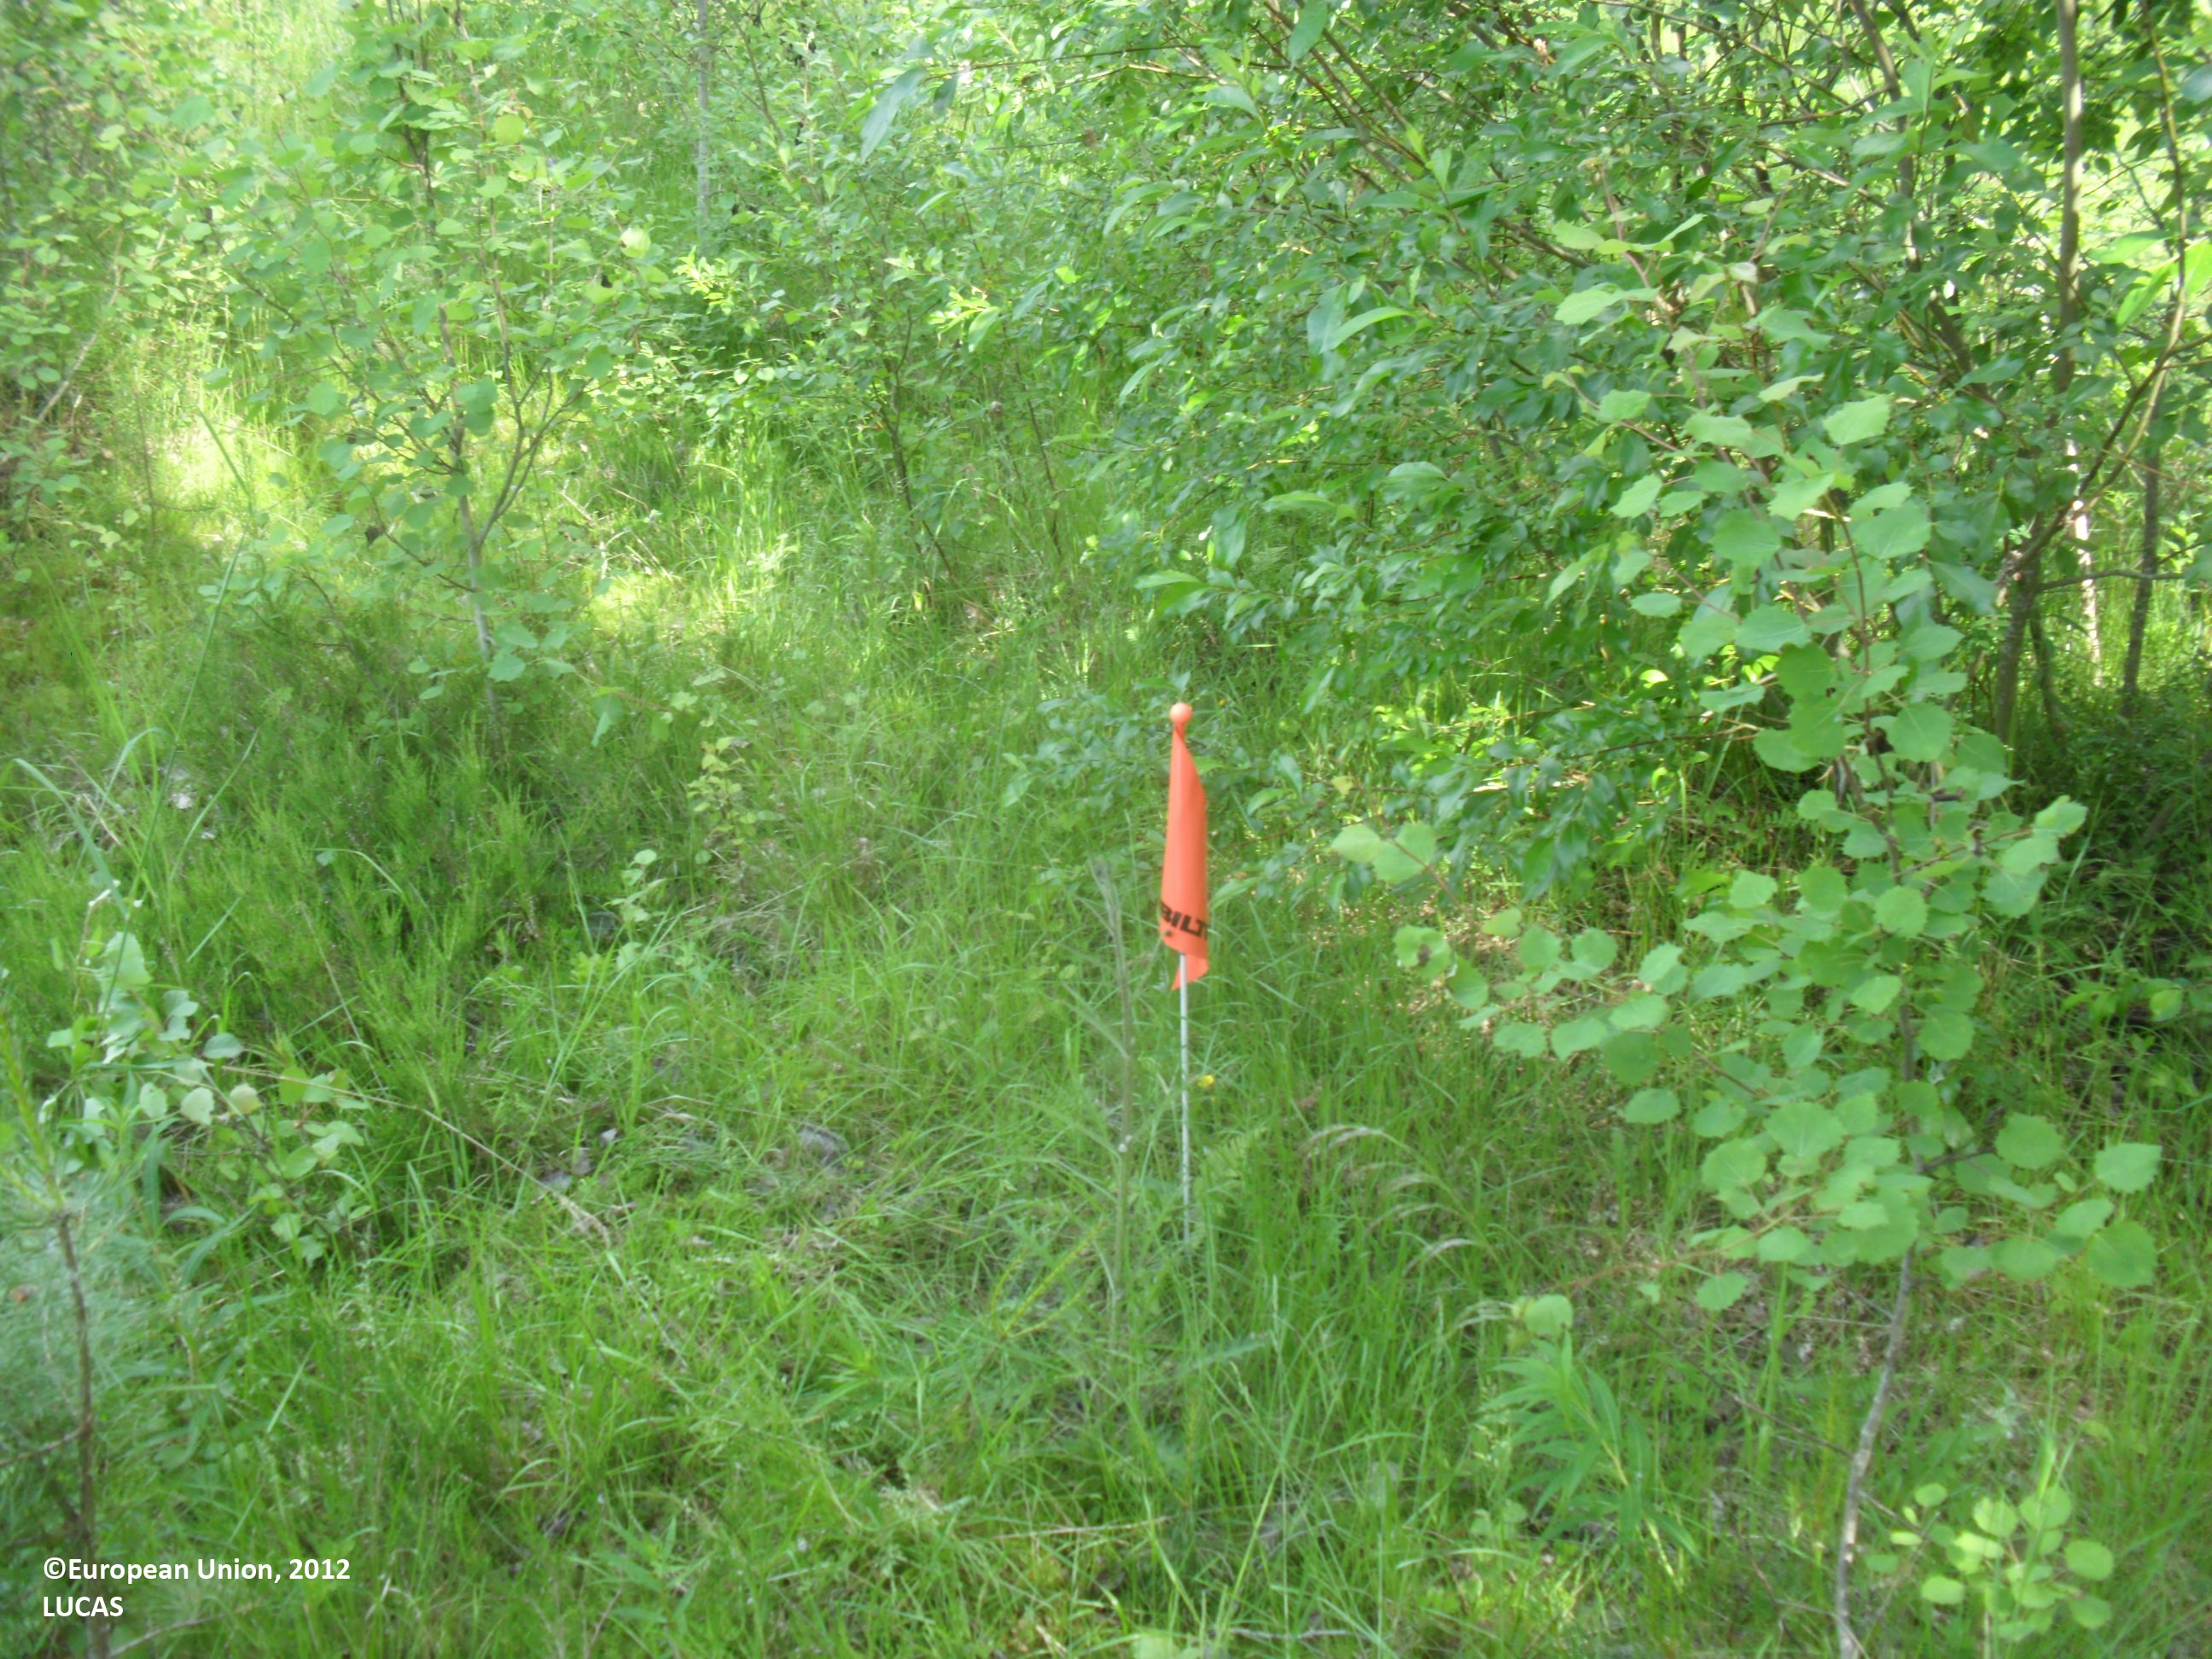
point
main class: Woodland
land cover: Pine dominated mixed woodland
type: boreal forest
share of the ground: 50 - 75 %
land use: Forestry
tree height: > 5 m
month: July
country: FI
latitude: 63.4563
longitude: 23.8475
